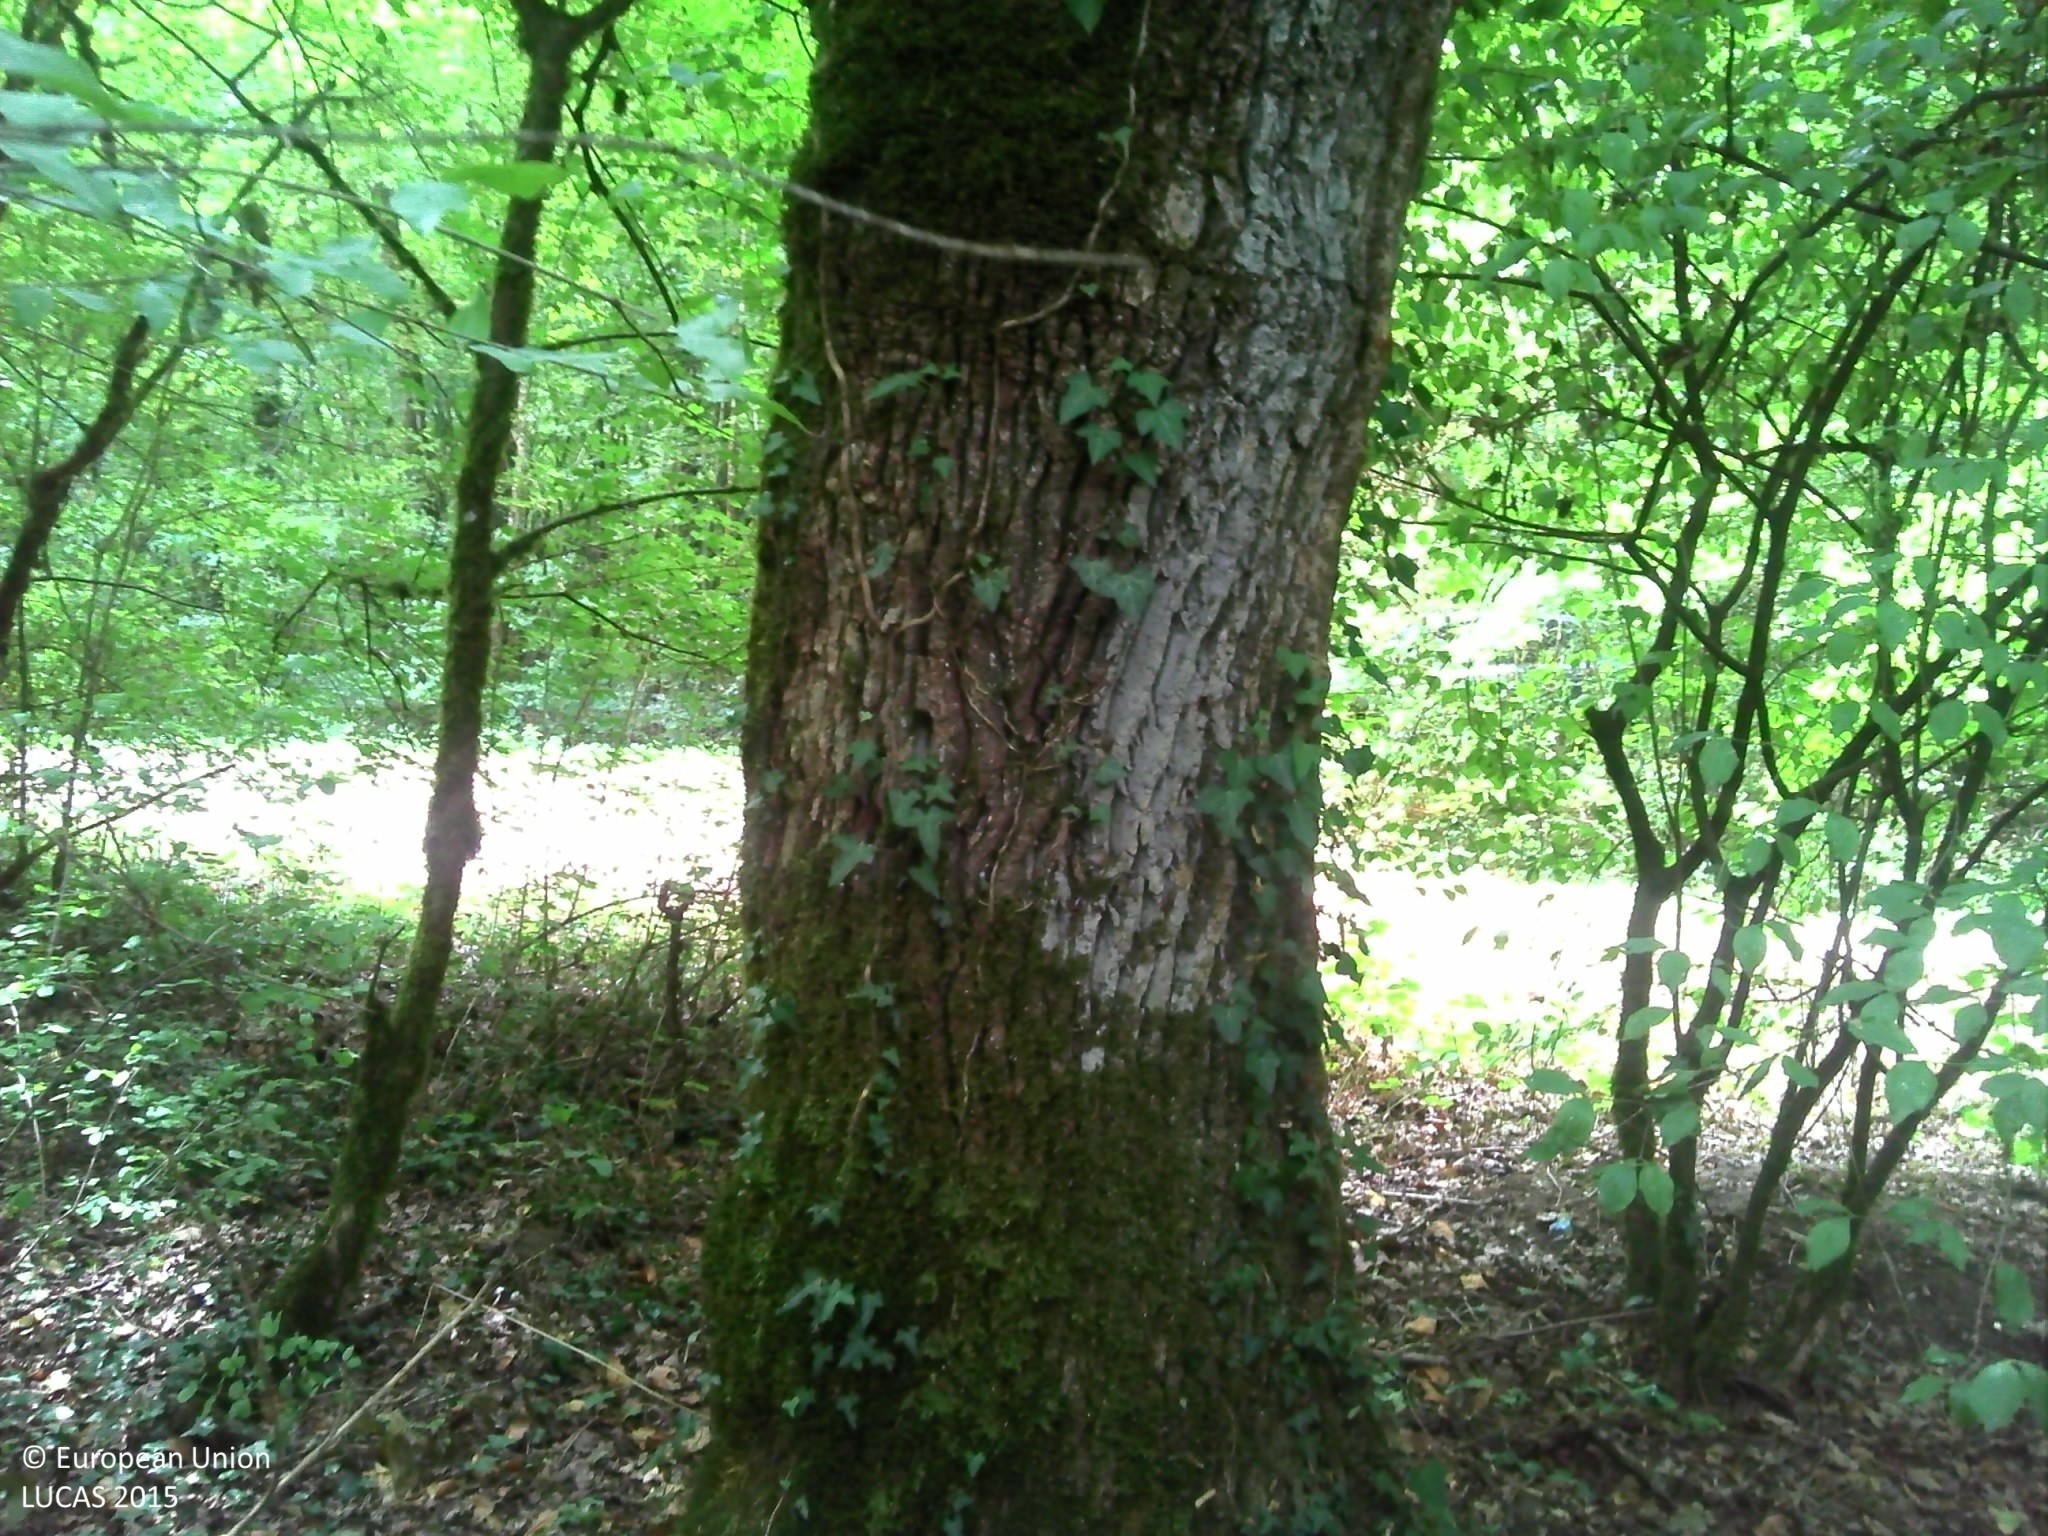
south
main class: Woodland
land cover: Broadleaved woodland
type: mesophytic deciduous forest
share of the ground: > 75 %
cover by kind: broadleaved forest trees 90 %, shrubs 5 %, herbaceous plants 5 %
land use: Forestry
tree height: > 5 m
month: July
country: FR
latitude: 45.7668
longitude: 5.4393
